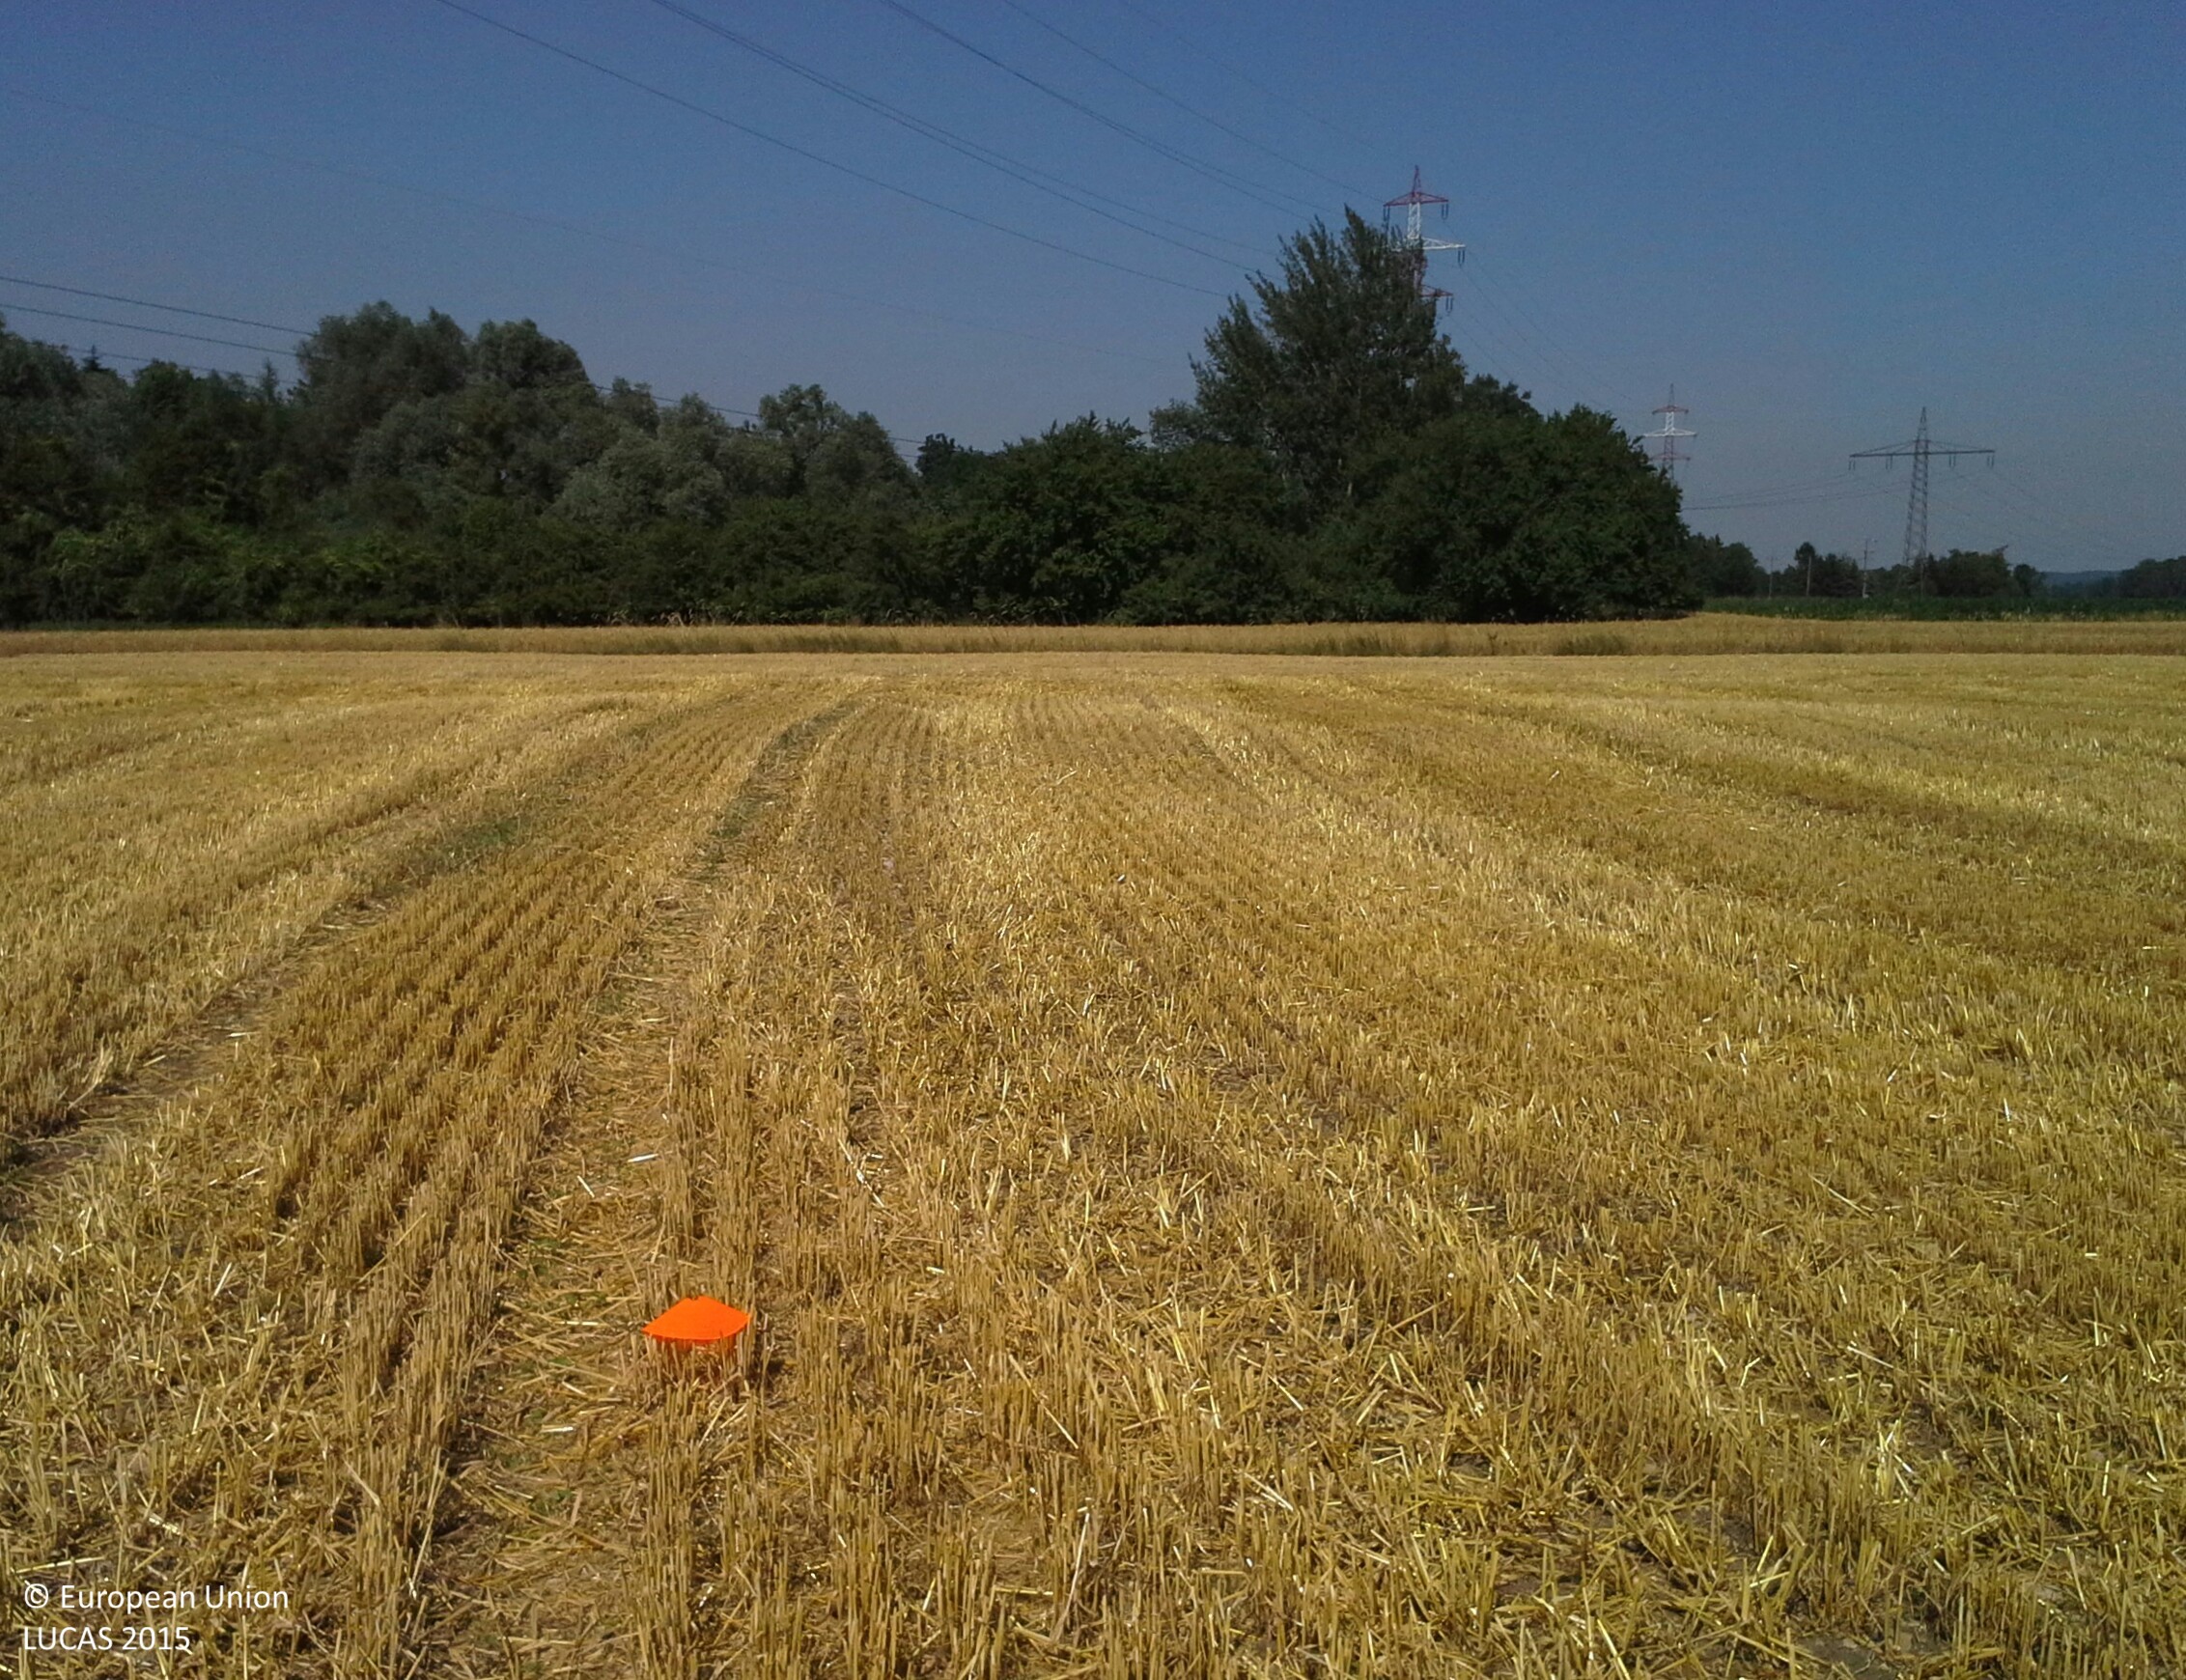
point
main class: Cropland
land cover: Barley
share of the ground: 25 - 50 %
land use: Agriculture (excluding fallow land and kitchen gardens)
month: July
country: AT
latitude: 48.1121
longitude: 14.9572
